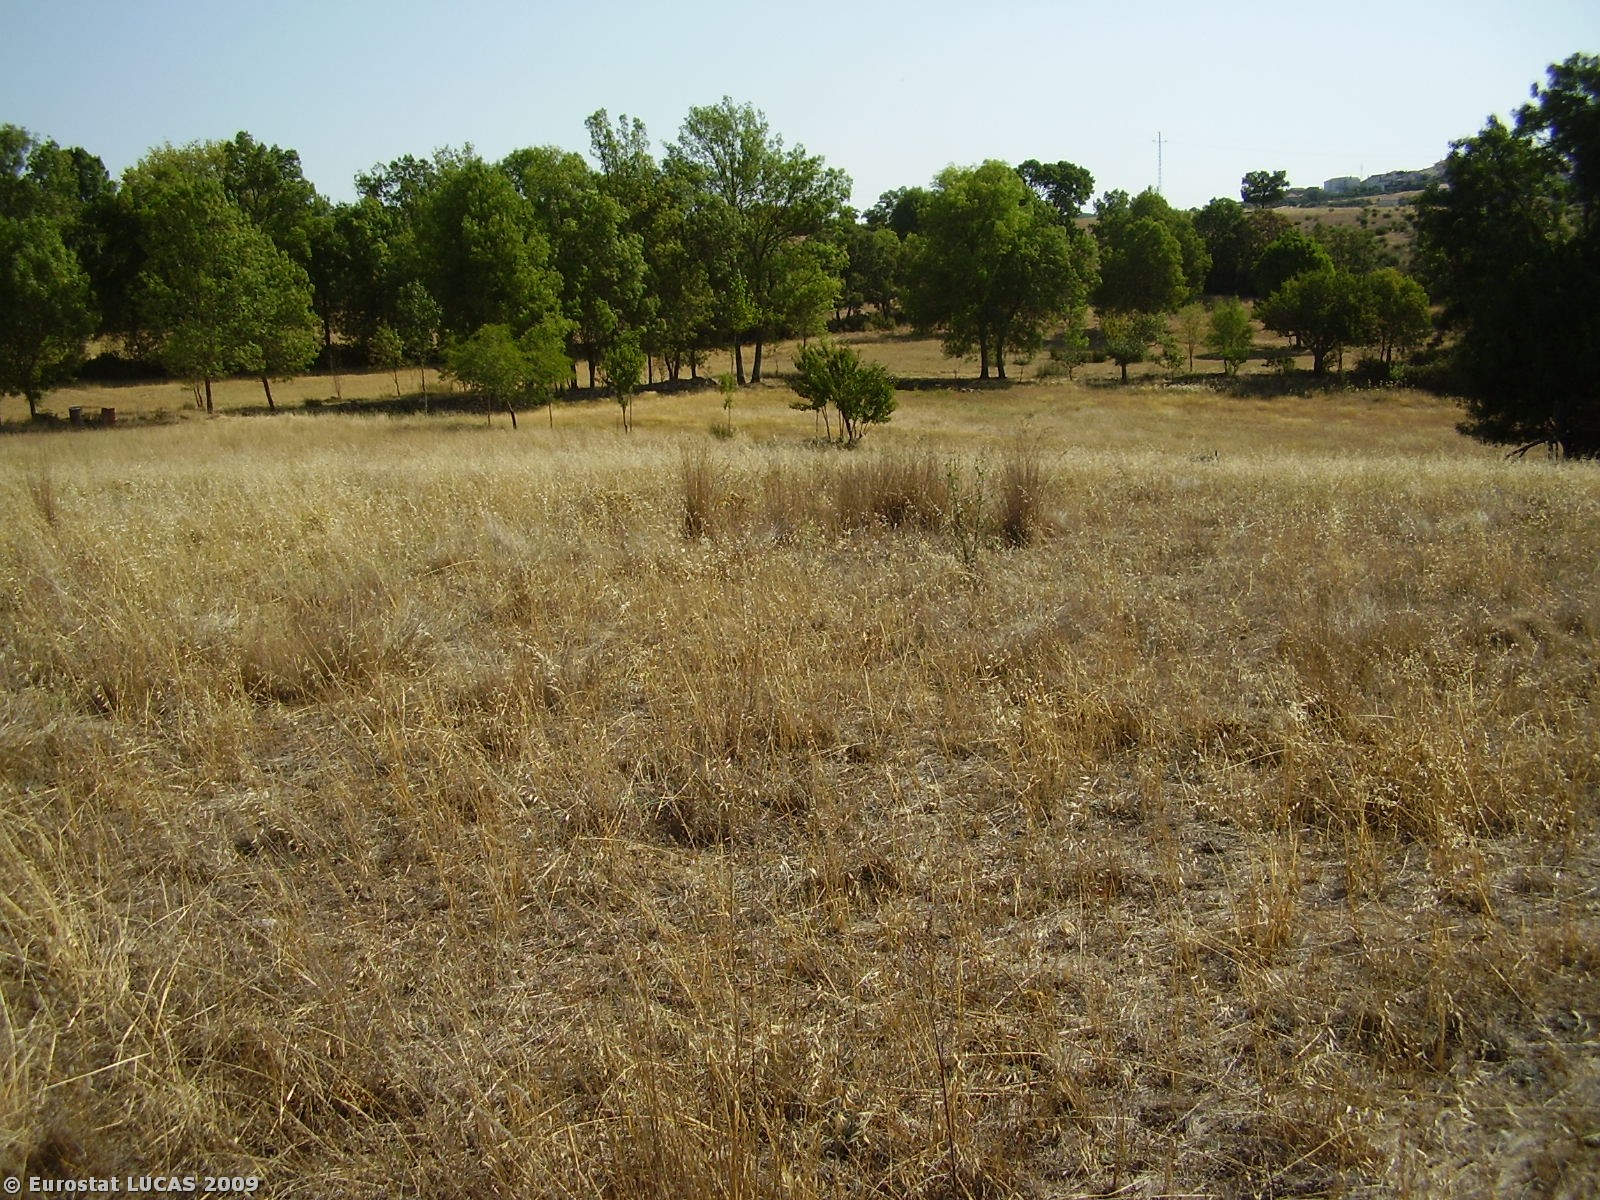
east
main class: Grassland
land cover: Grassland without tree/shrub cover
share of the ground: > 75 %
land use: Fallow land
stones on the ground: > 50 %
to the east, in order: Grassland without tree/shrub cover; Single bushes/trees; Grassland without tree/shrub cover; Shrubland with sparse tree cover; Rivers and streams; Dry stone walls; Maize; Dry stone walls; Shrubland with sparse tree cover; Grassland with sparse tree/shrub cover; Dry stone walls; Broadleaved woodland; Shrubland without tree cover; Spontaneously vegetated surfaces
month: August
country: PT
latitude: 41.3431
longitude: -6.7291
